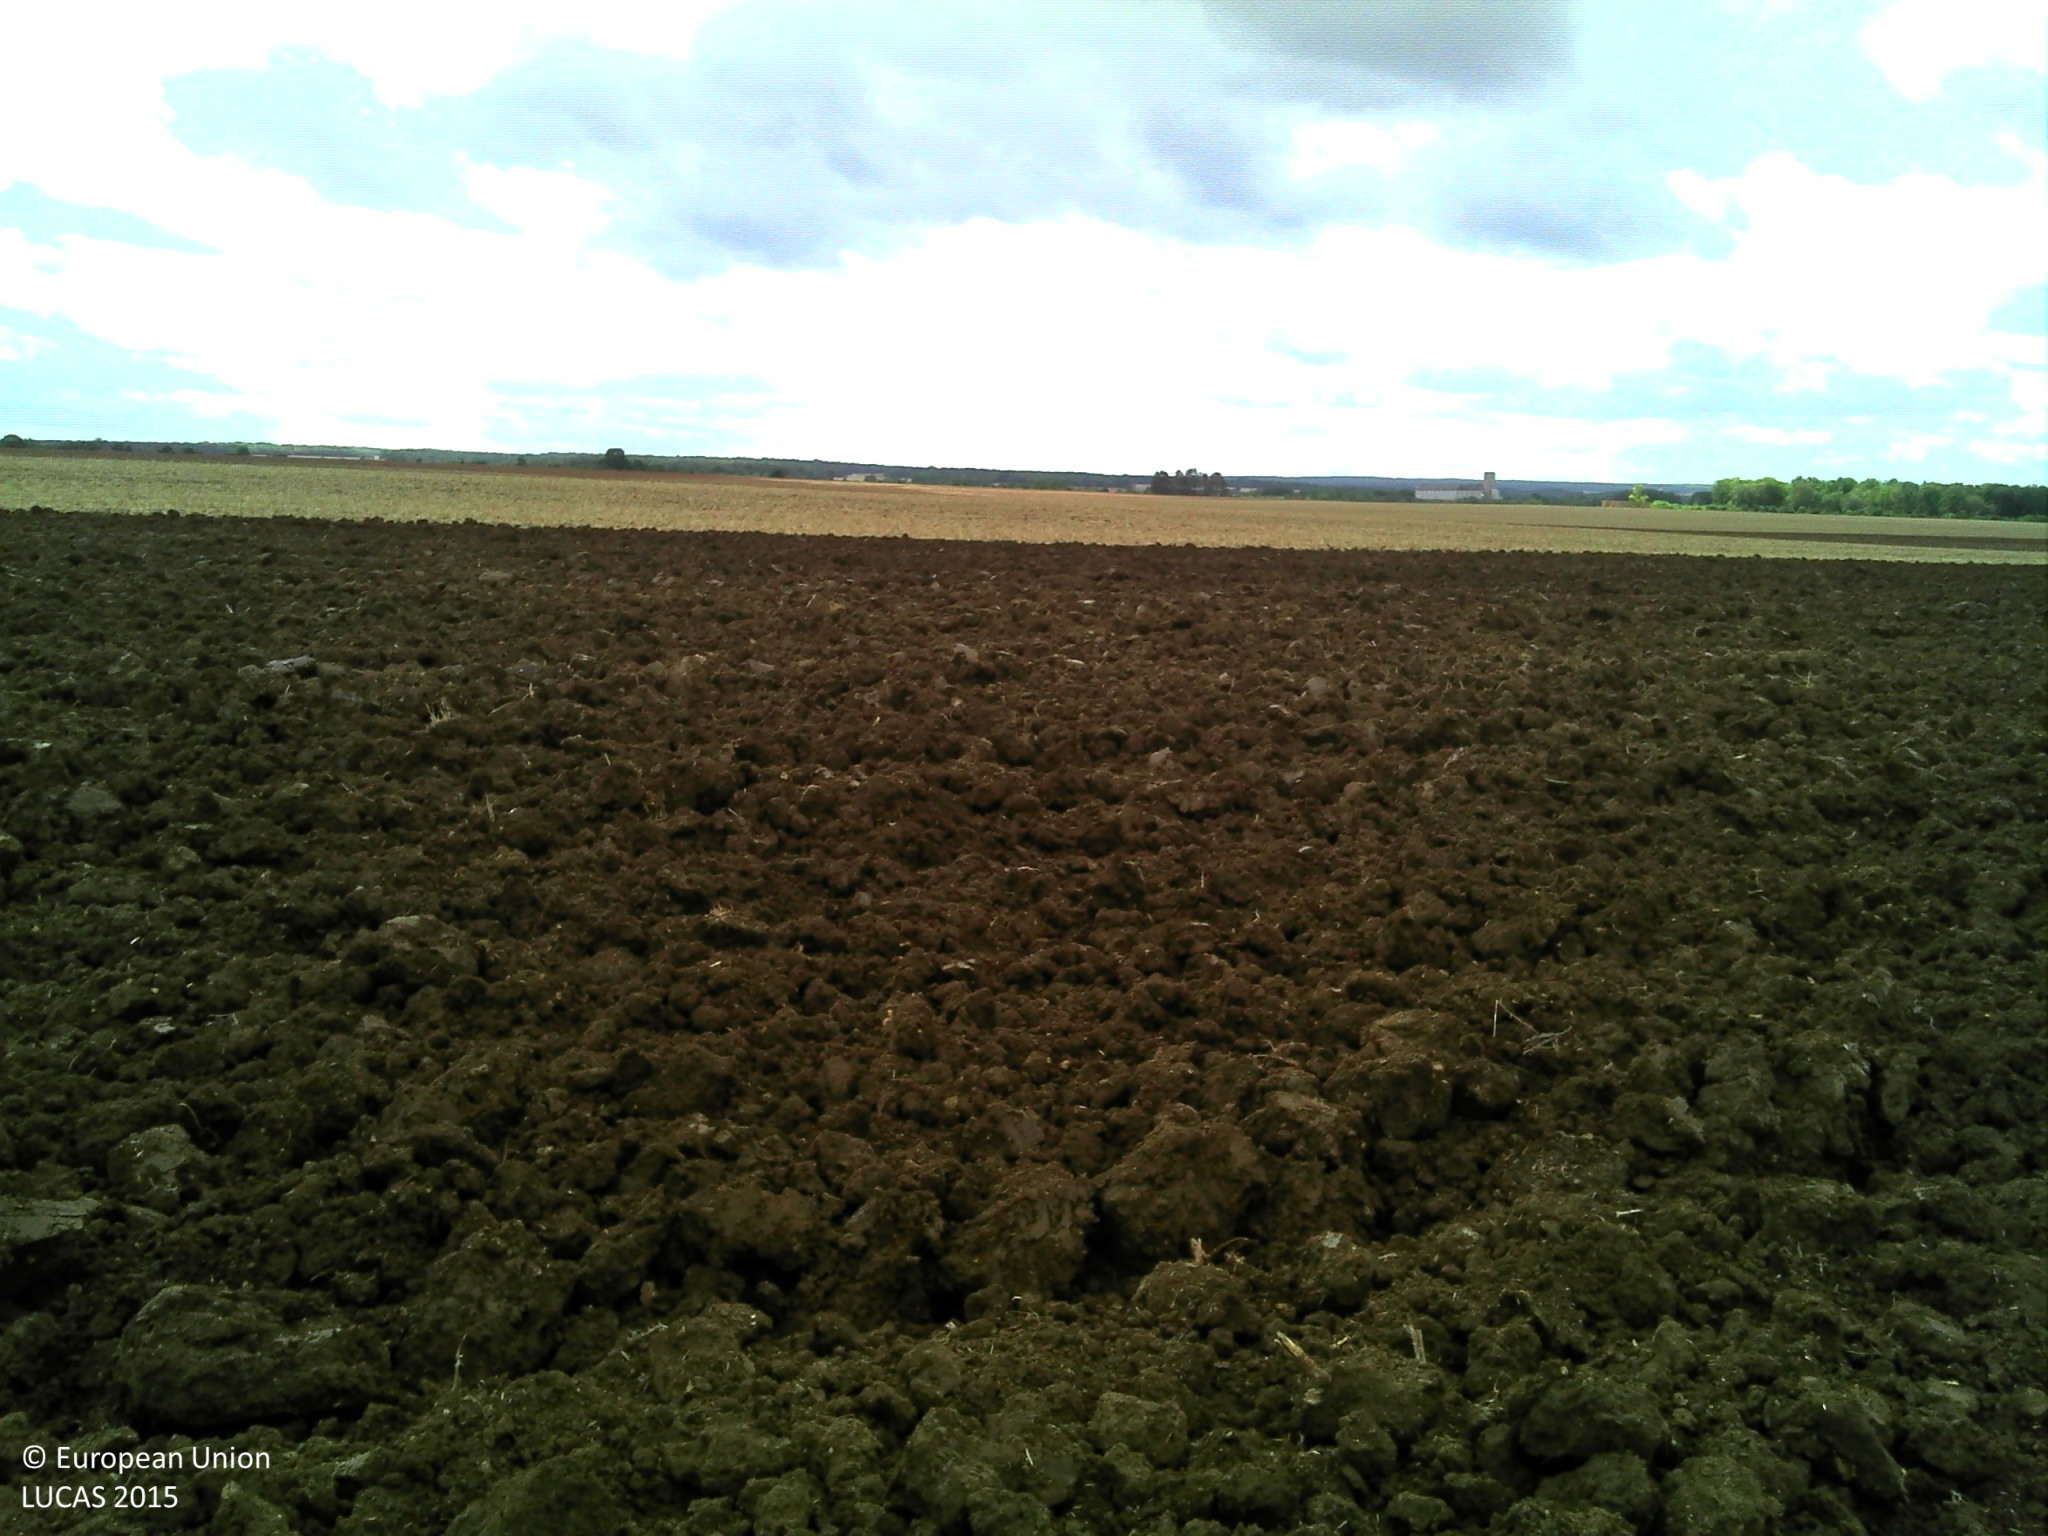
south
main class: Cropland
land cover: Rape and turnip rape
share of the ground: < 10 %
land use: Agriculture (excluding fallow land and kitchen gardens)
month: August
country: FR
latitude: 47.9574
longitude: 4.8163
